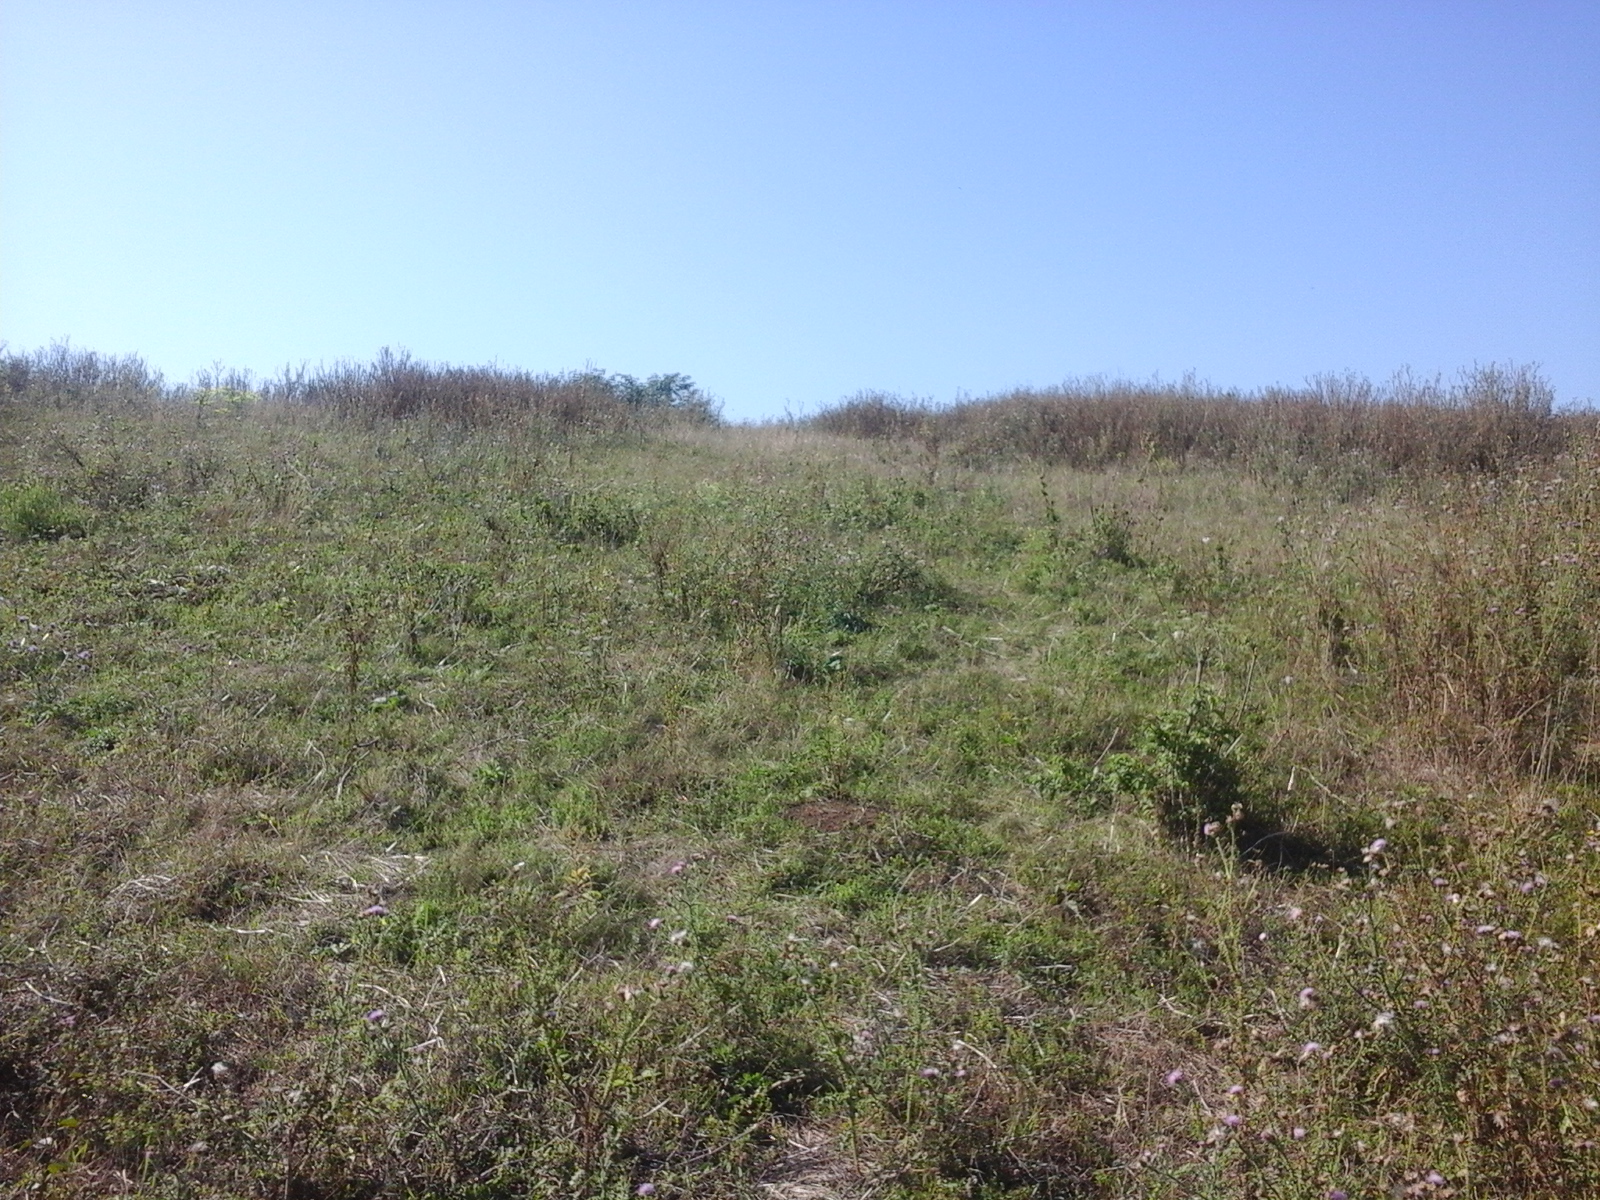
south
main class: Grassland
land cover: Spontaneously vegetated surfaces
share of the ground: > 75 %
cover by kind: herbaceous plants 100 %
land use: Fallow land
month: August
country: RO
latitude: 45.8809
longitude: 21.0978
